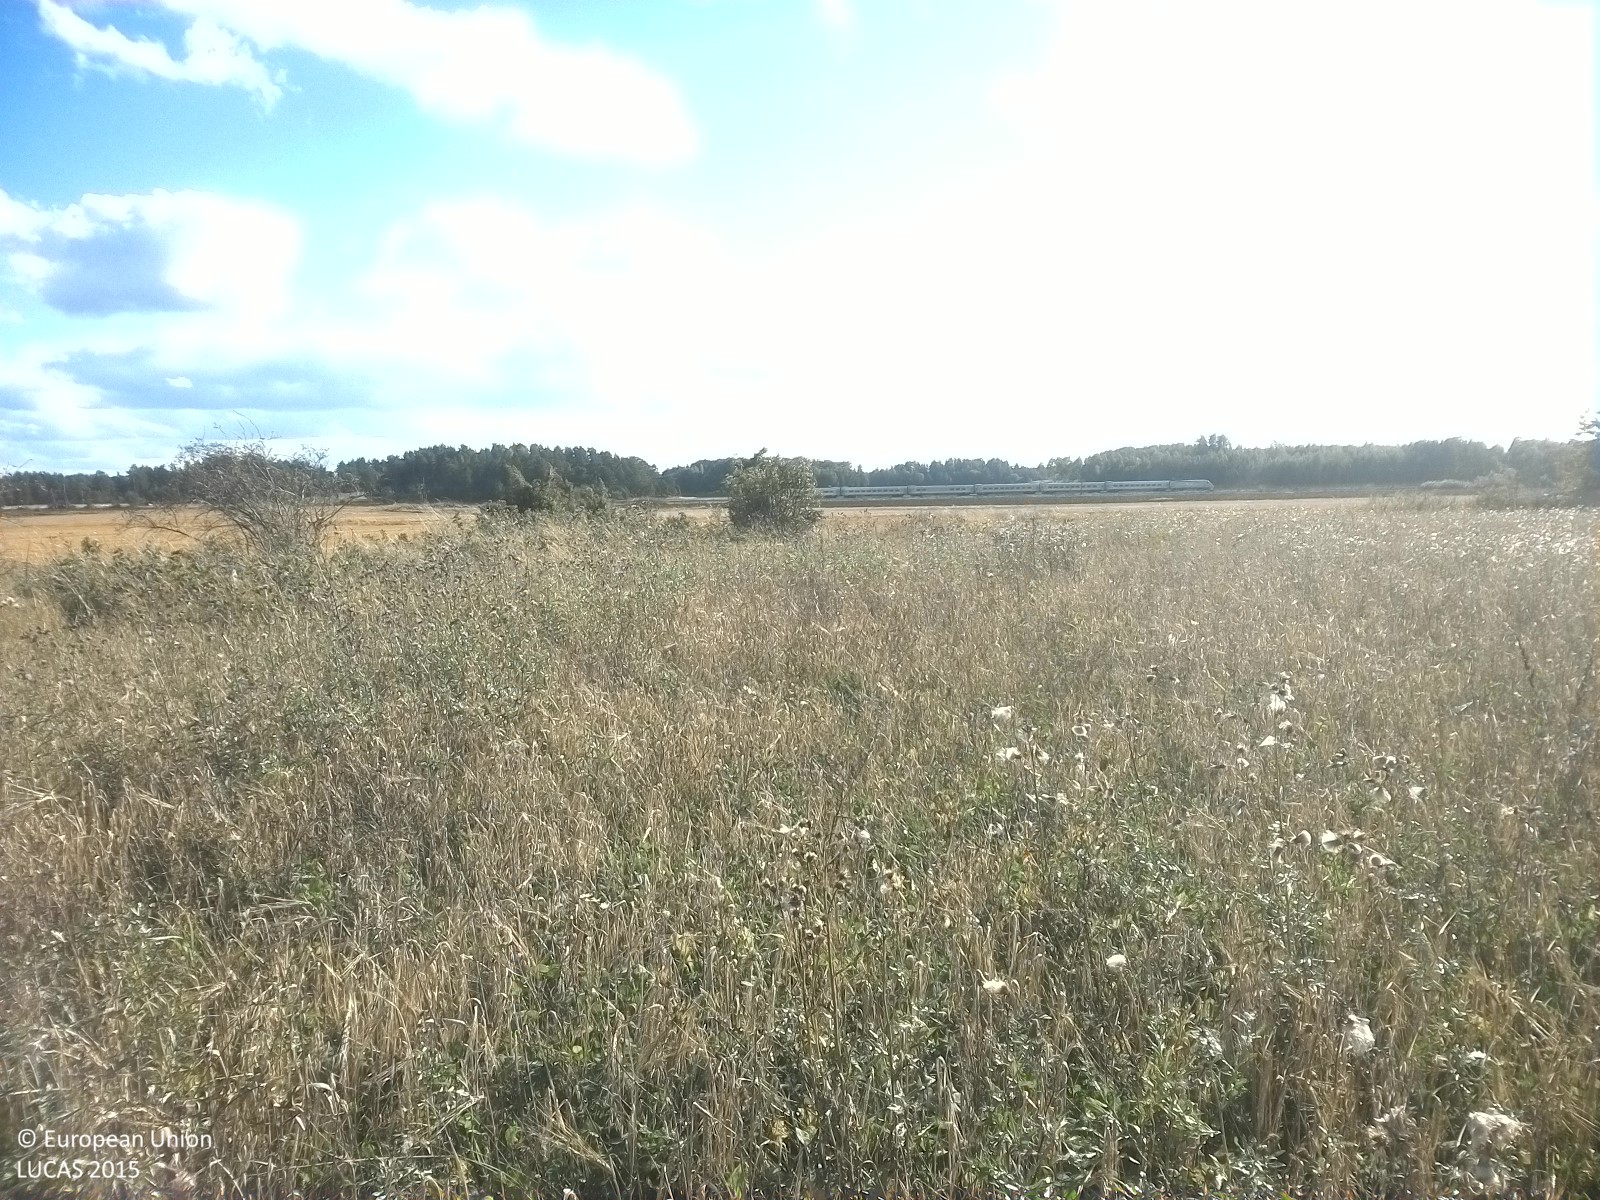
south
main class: Grassland
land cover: Spontaneously vegetated surfaces
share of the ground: > 75 %
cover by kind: herbaceous plants 100 %
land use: Agriculture (excluding fallow land and kitchen gardens)
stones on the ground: < 10 %
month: September
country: SE
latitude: 58.4235
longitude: 15.6963
